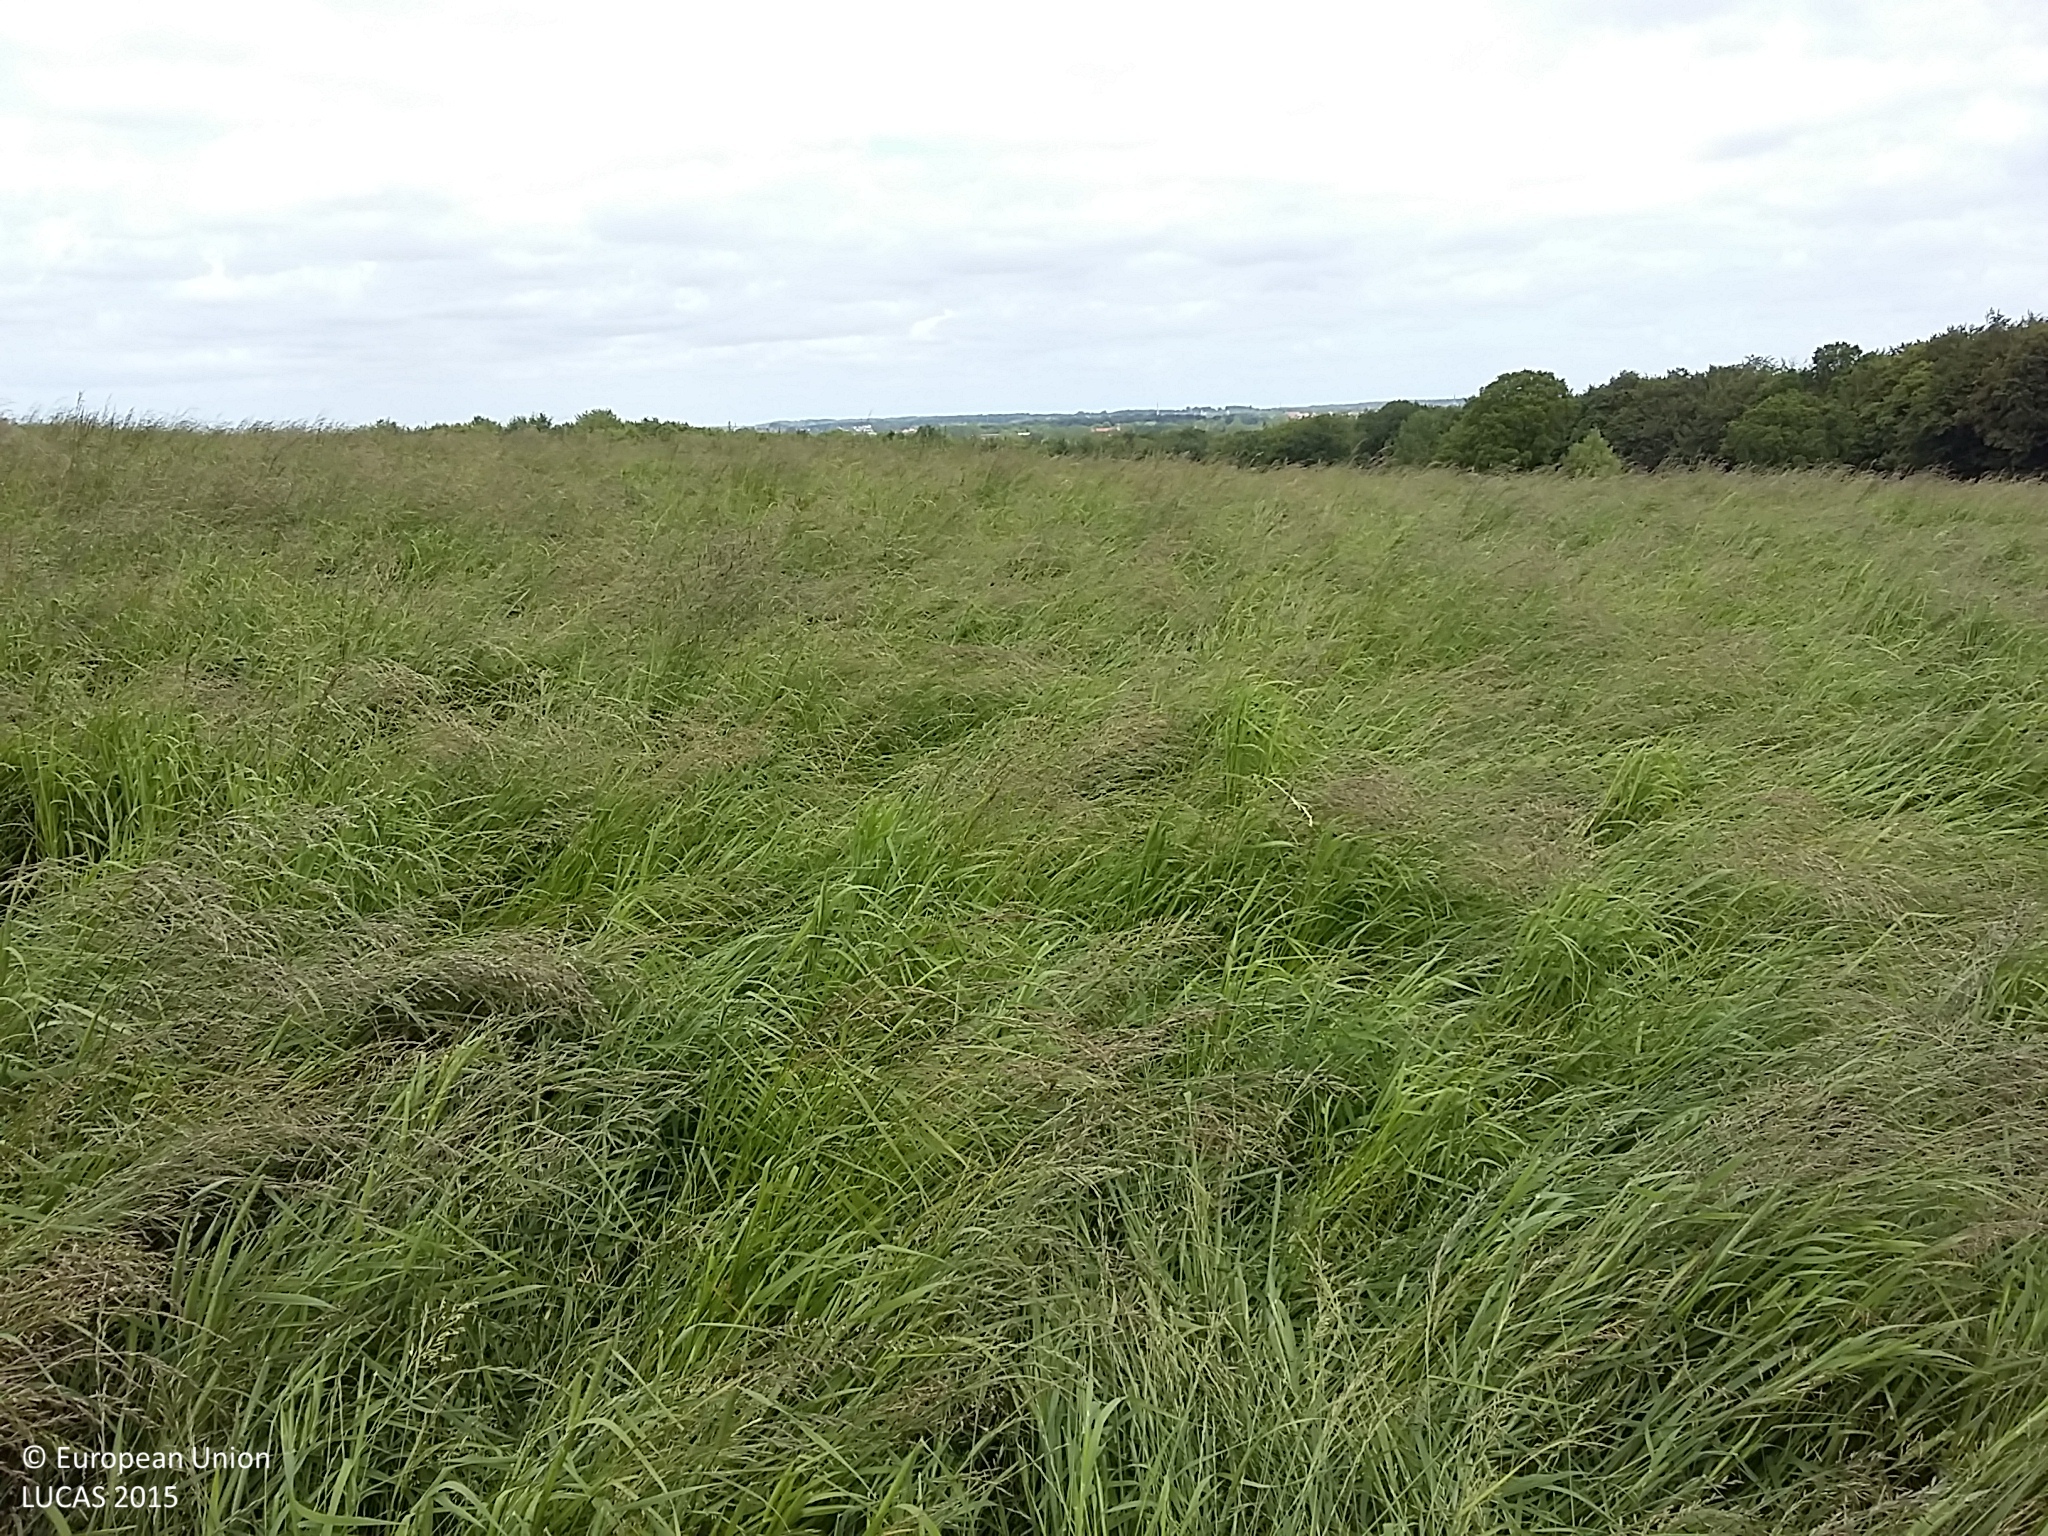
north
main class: Cropland
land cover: Temporary grasslands
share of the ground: > 75 %
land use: Agriculture (excluding fallow land and kitchen gardens)
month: June
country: DK
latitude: 55.2687
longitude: 10.7705
